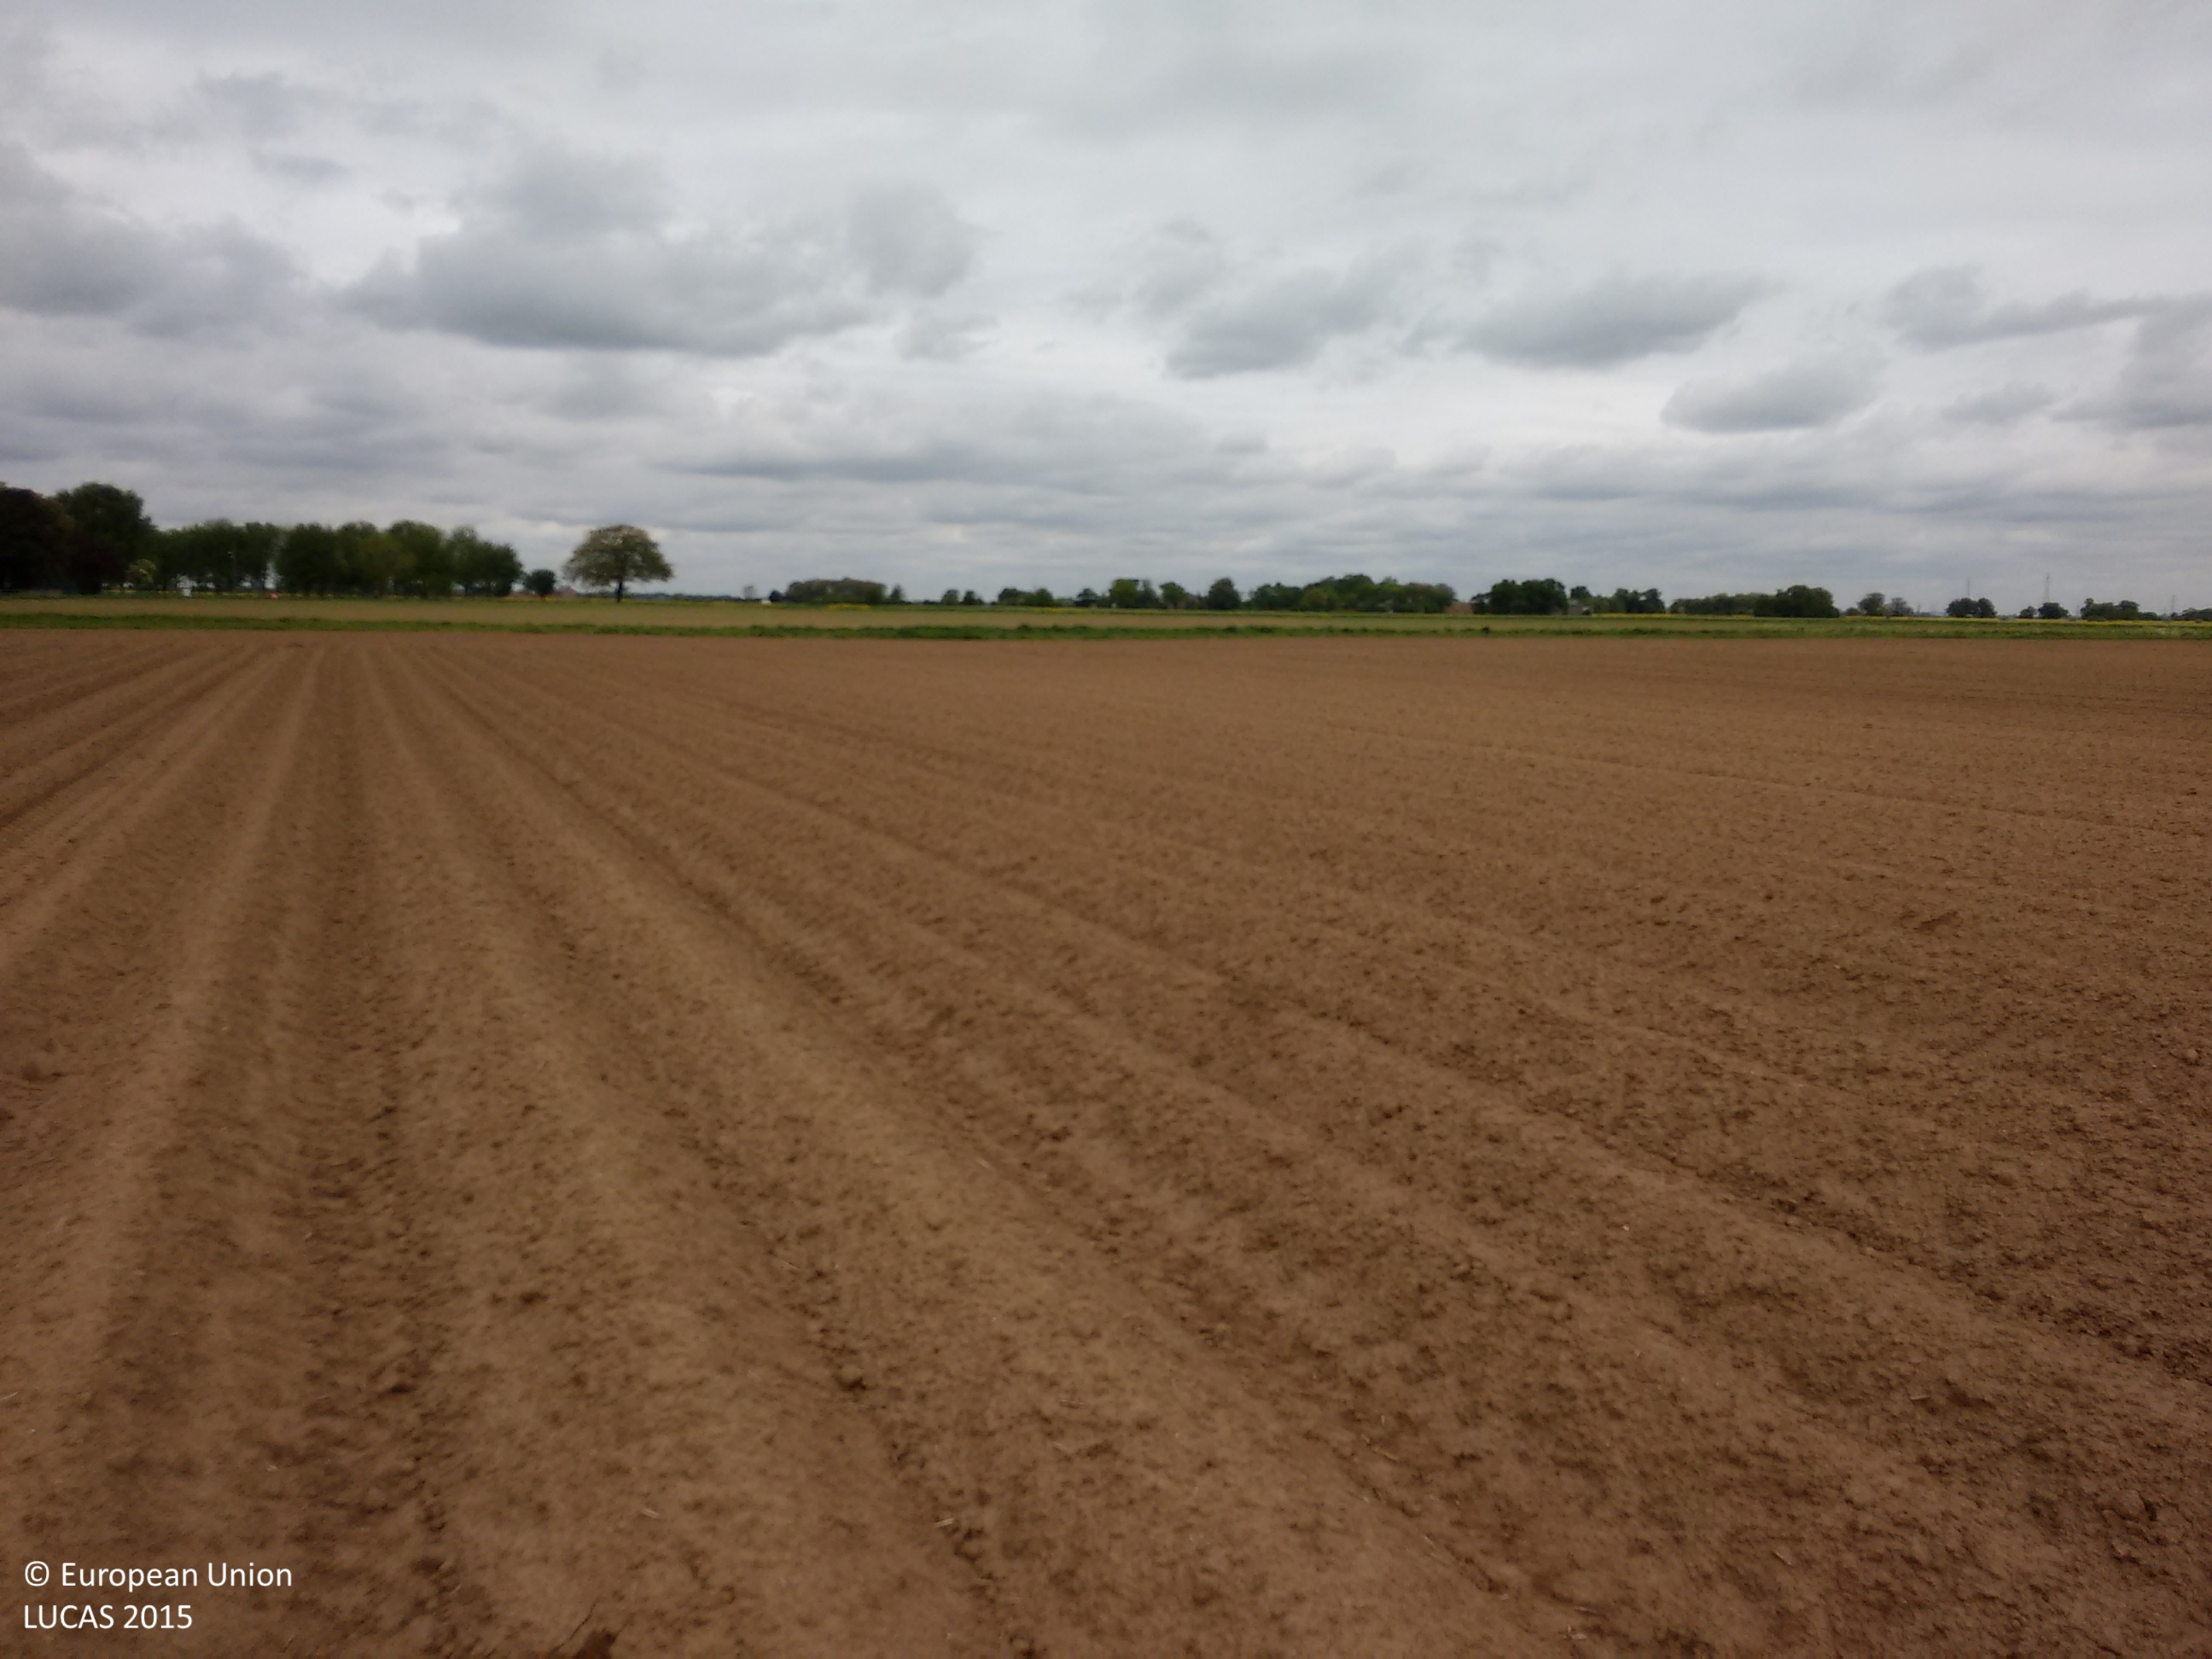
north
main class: Cropland
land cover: Potatoes
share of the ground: < 10 %
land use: Agriculture (excluding fallow land and kitchen gardens)
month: May
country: GB
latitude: 53.6640
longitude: -0.7702
